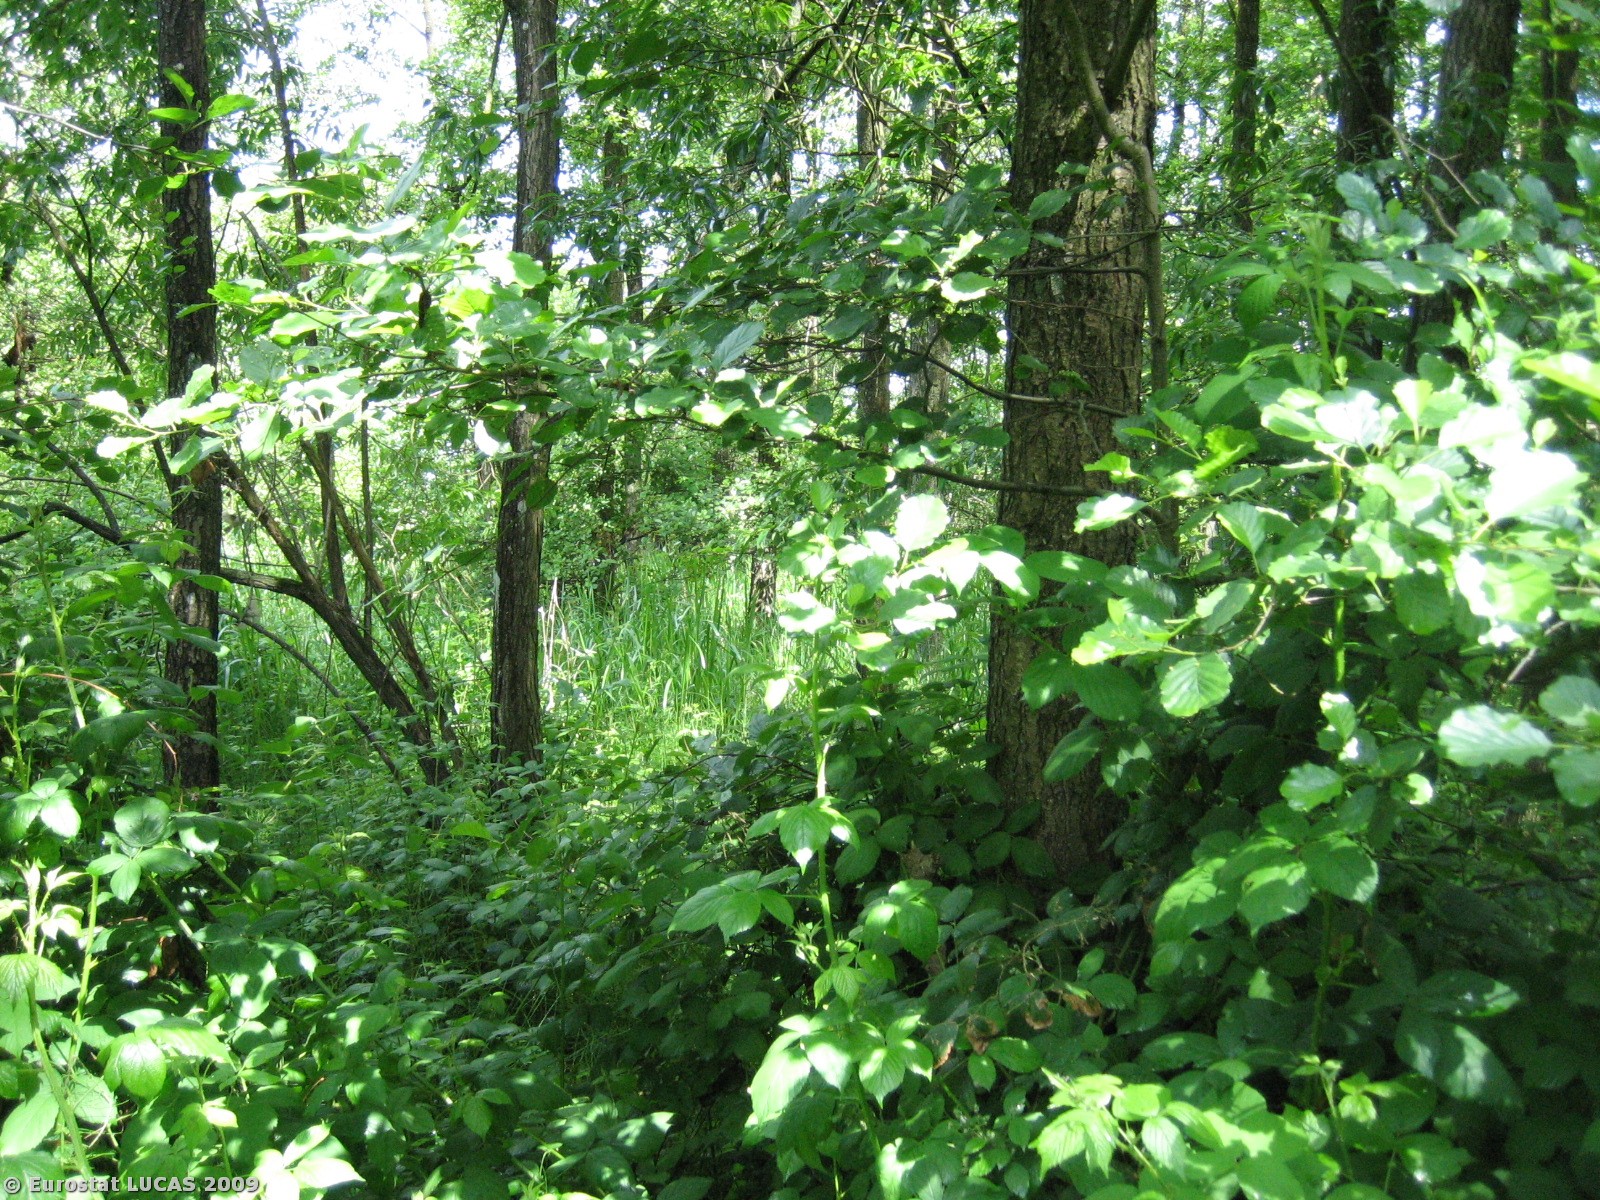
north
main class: Woodland
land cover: Broadleaved woodland
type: non-riverine alder, birch or aspen forest
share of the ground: > 75 %
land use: Agriculture (excluding fallow land and kitchen gardens)
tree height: > 5 m
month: June
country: DK
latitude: 55.6123
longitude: 9.7304
